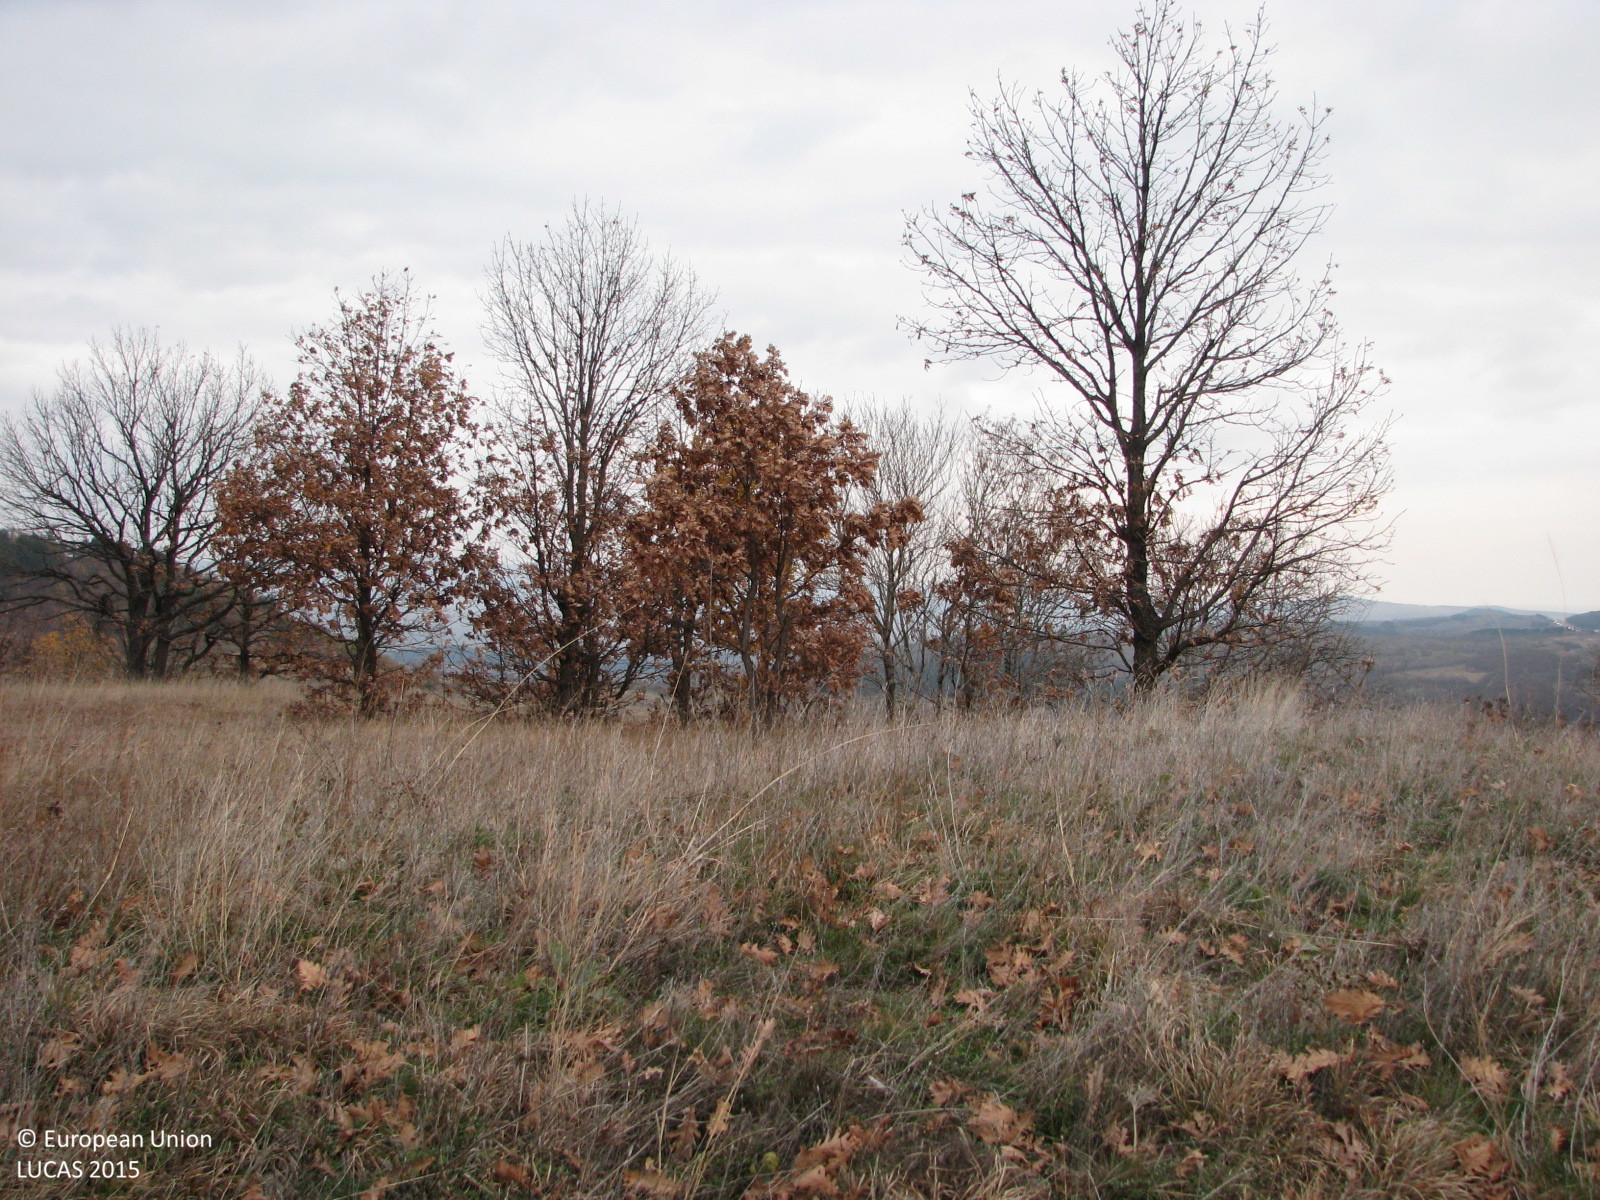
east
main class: Grassland
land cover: Grassland with sparse tree/shrub cover
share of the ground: > 75 %
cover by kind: herbaceous plants 90 %, broadleaved forest trees 5 %, shrubs 5 %
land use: Agriculture (excluding fallow land and kitchen gardens)
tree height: < 5 m
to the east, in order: Grassland with sparse tree/shrub cover; Broadleaved woodland; Grassland with sparse tree/shrub cover; Abandoned hedges; Grassland without tree/shrub cover
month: December
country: BG
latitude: 42.3514
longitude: 24.0142
